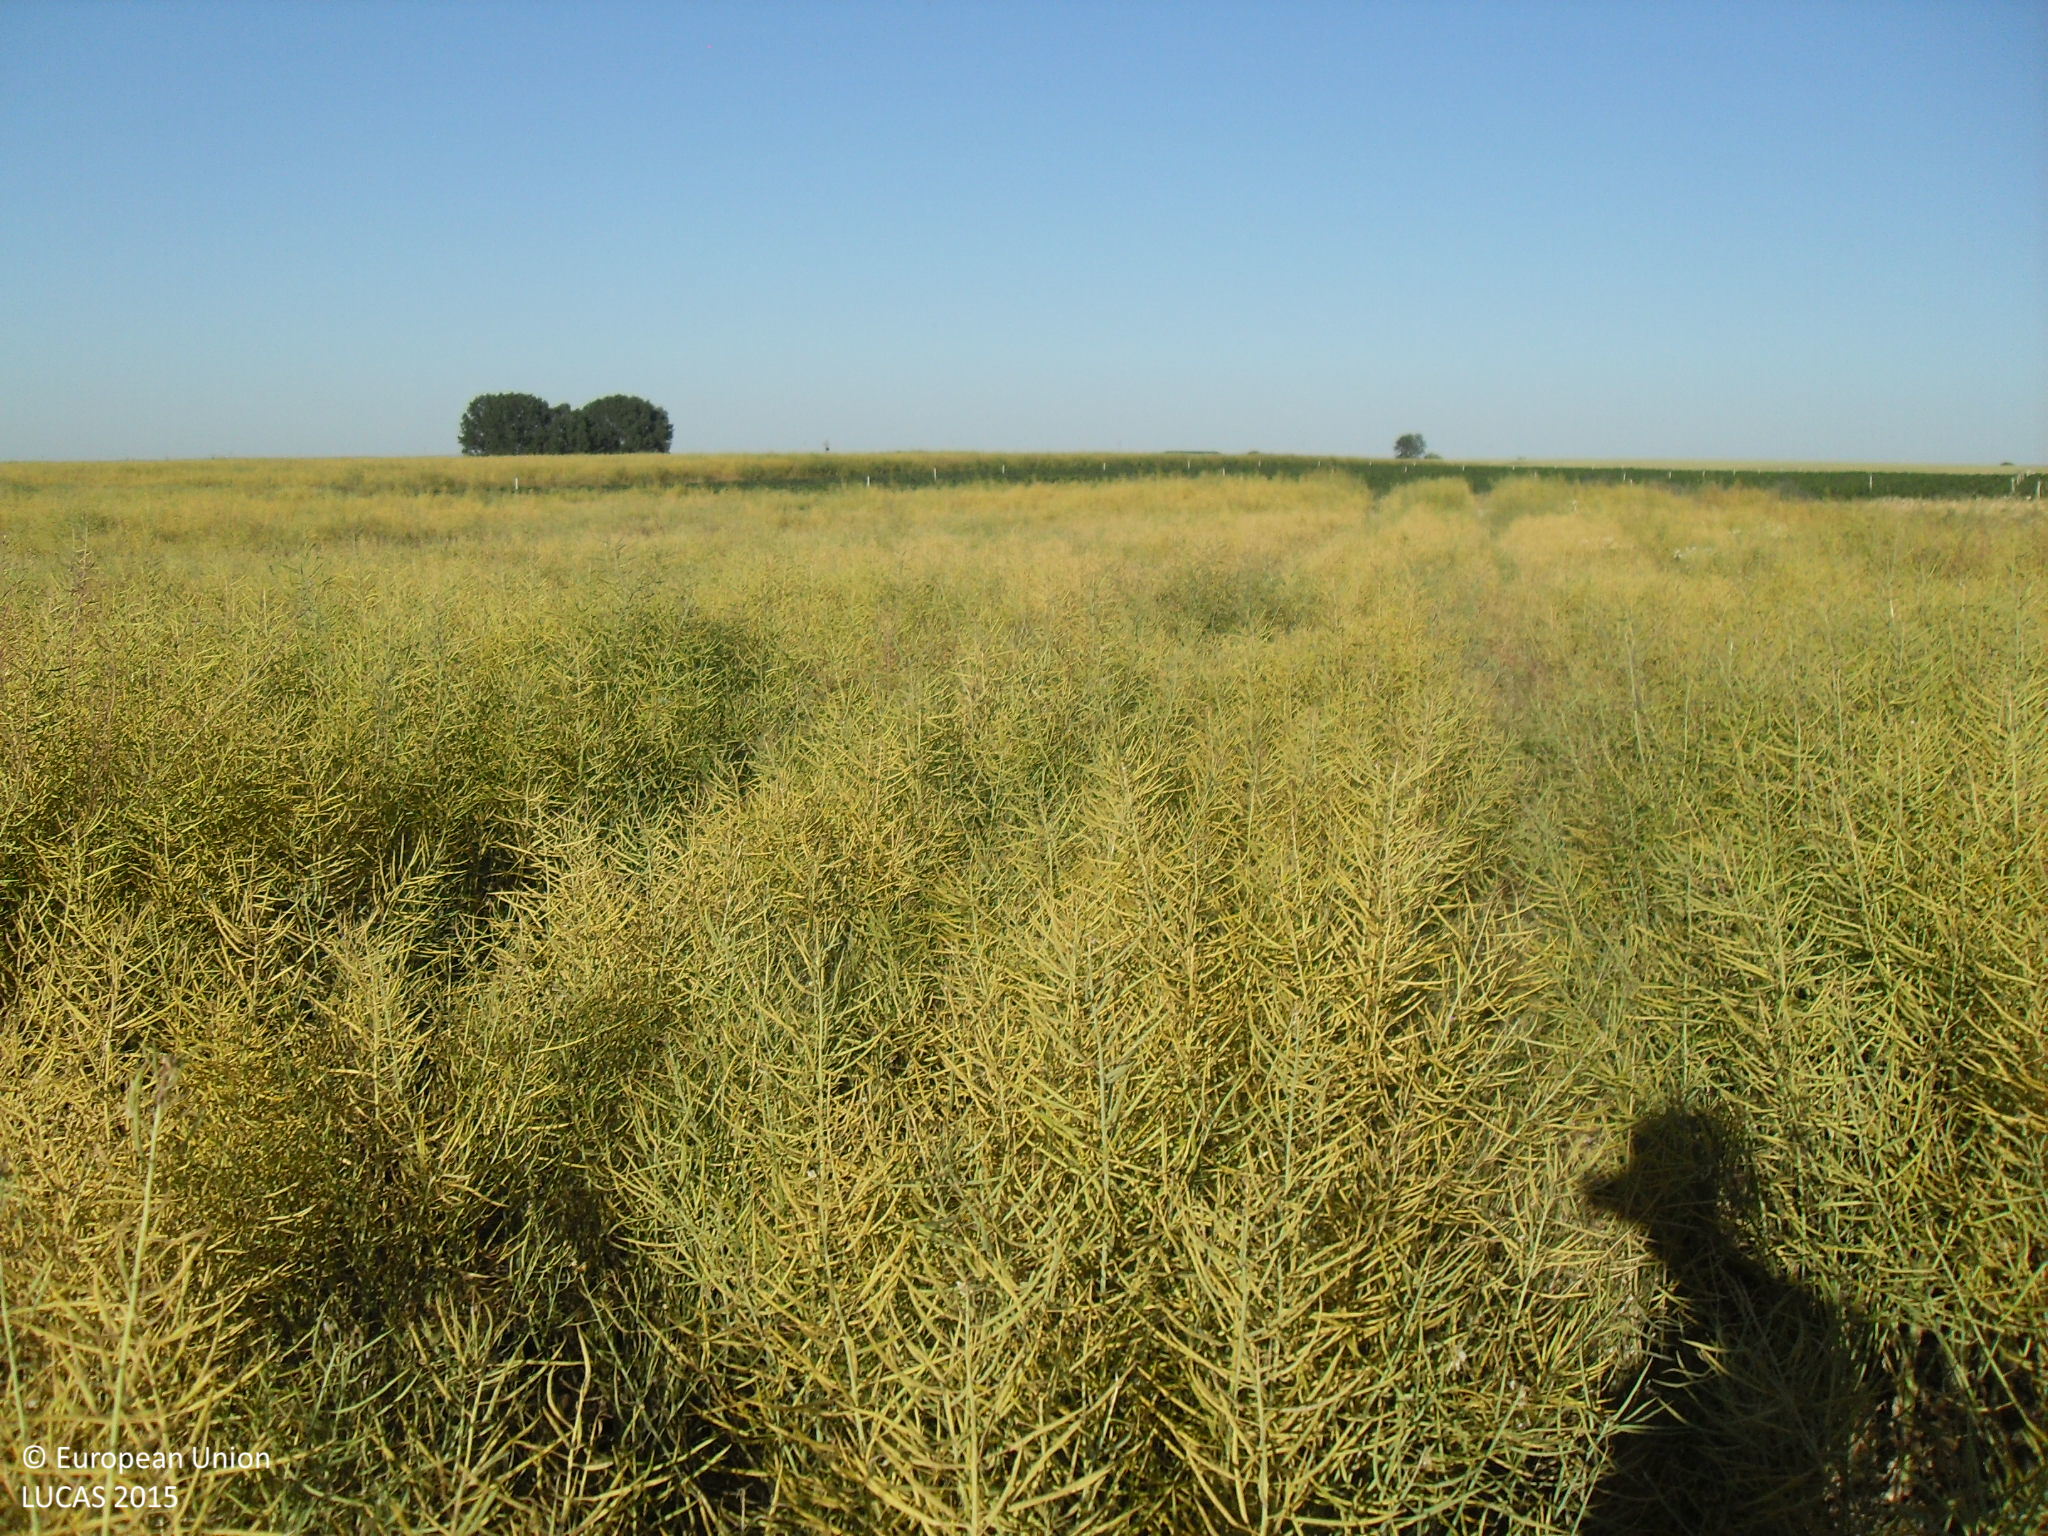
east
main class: Cropland
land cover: Rape and turnip rape
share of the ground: > 75 %
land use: Agriculture (excluding fallow land and kitchen gardens)
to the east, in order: Rape and turnip rape; Grass margins; Potatoes; Rape and turnip rape
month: May
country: ES
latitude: 41.0872
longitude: -5.3702
